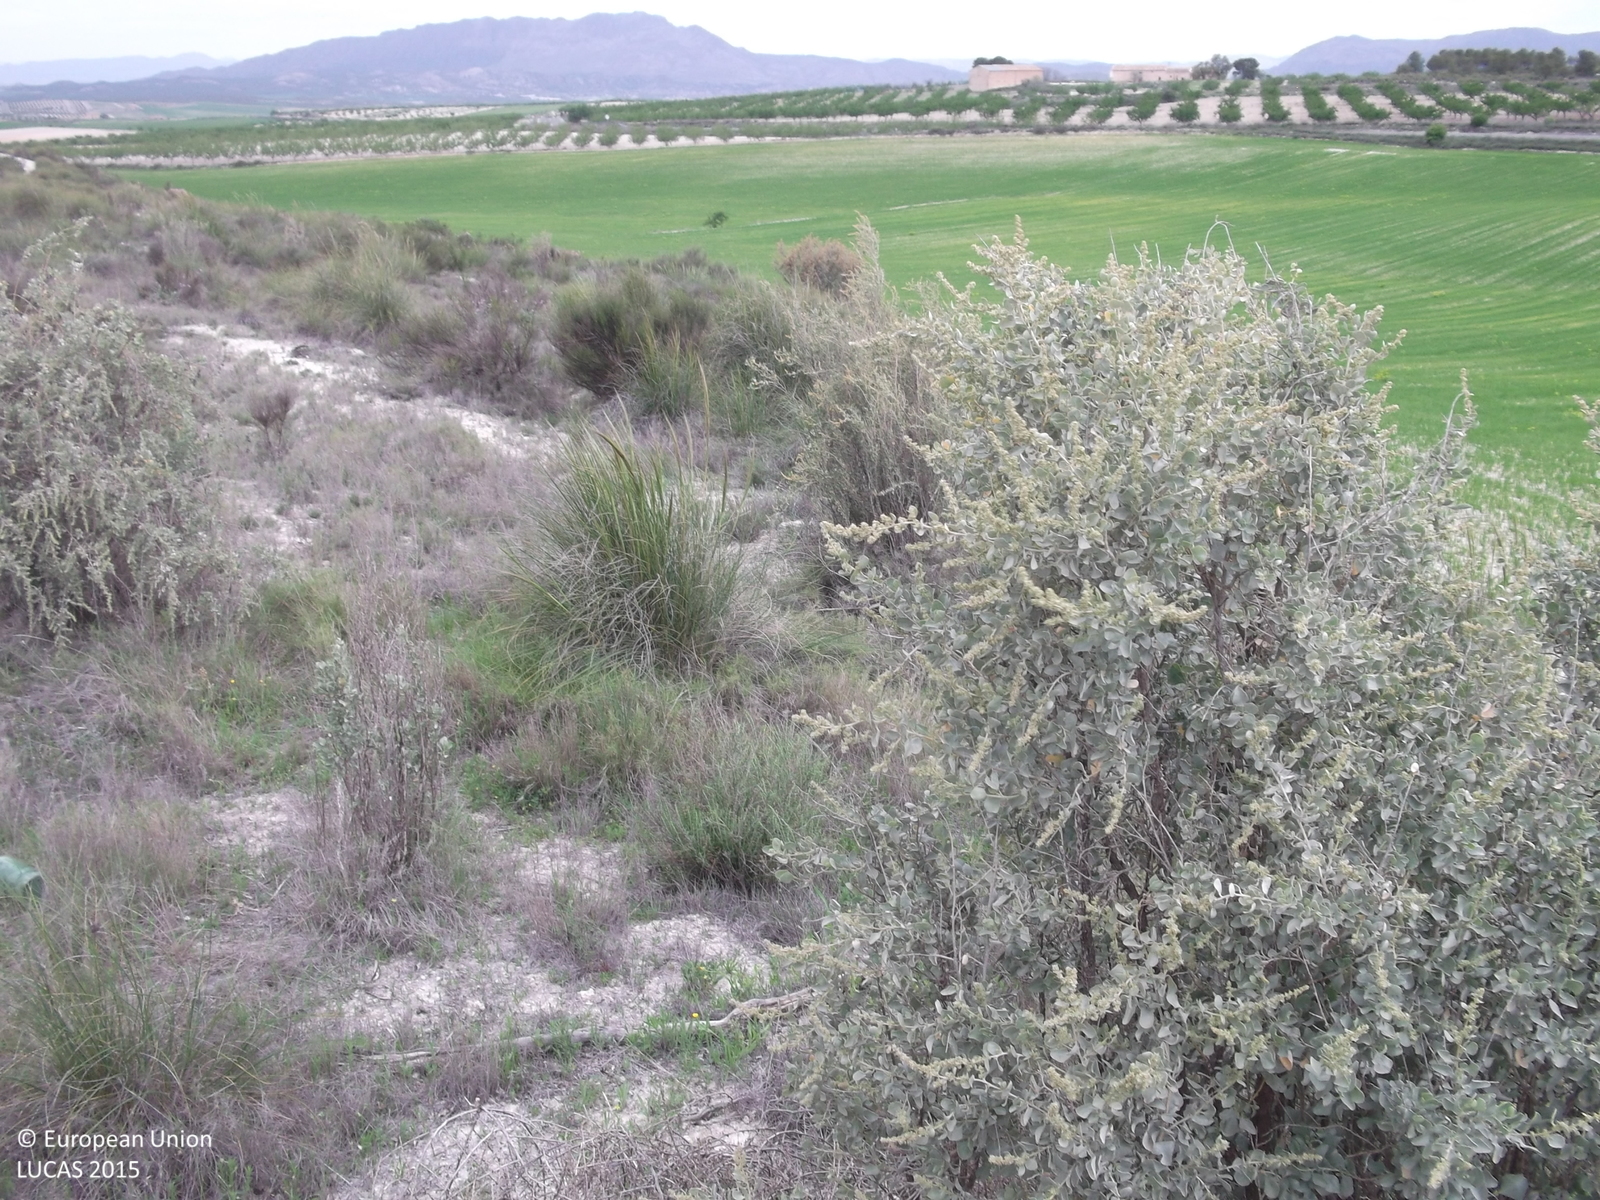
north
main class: Shrubland
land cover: Shrubland without tree cover
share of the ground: 50 - 75 %
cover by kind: shrubs 50 %, herbaceous plants 50 %
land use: Abandoned areas
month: April
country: ES
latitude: 38.1341
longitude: -1.5908
